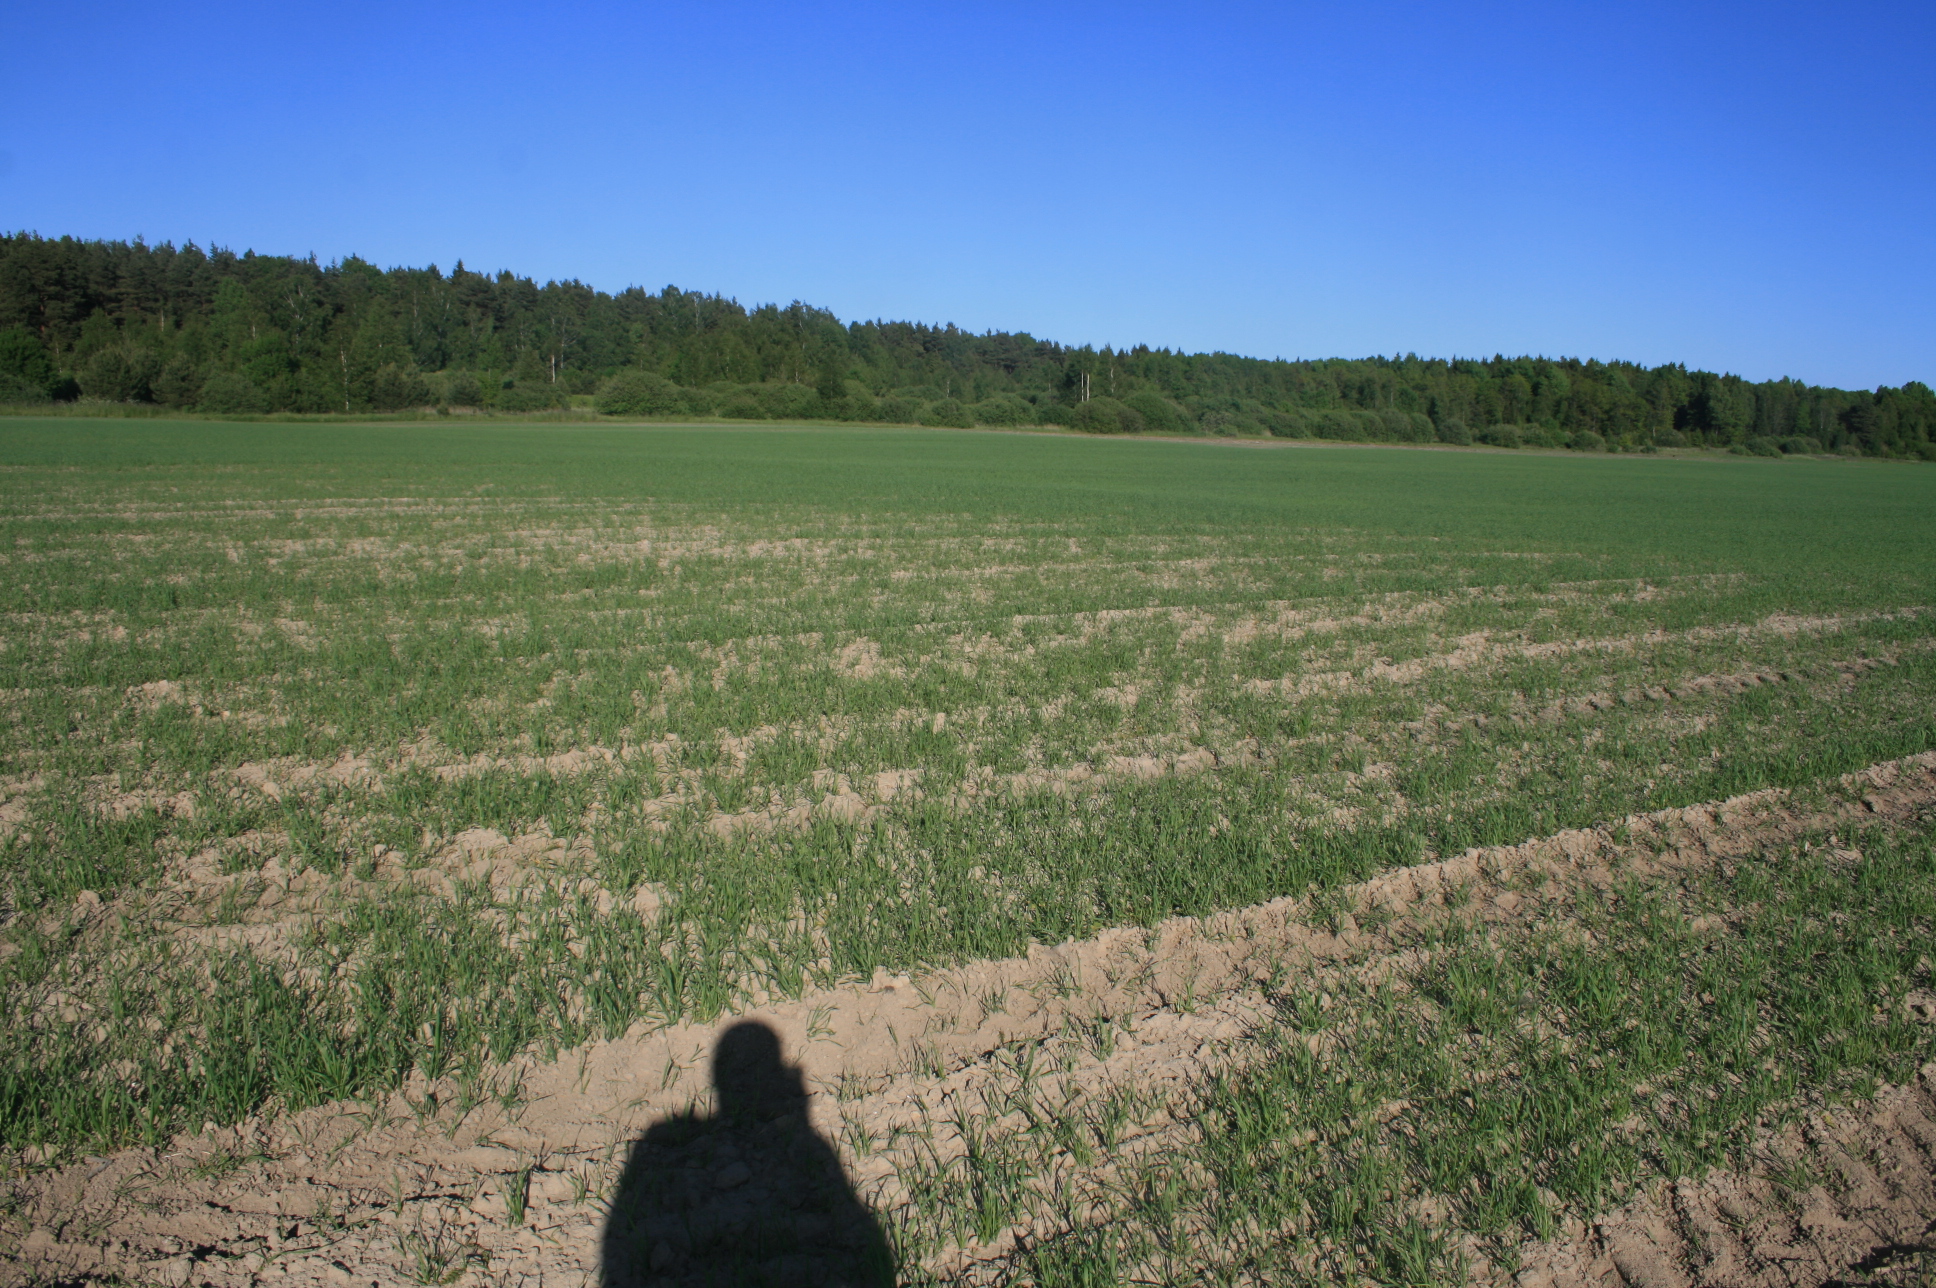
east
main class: Cropland
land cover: Barley
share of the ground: 50 - 75 %
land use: Agriculture (excluding fallow land and kitchen gardens)
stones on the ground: < 10 %
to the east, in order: Barley; Spontaneously vegetated surfaces; Broadleaved woodland; Spontaneously vegetated surfaces; Grassland with sparse tree/shrub cover; Inland fresh water bodies; Grassland with sparse tree/shrub cover
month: June
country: LT
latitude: 55.9210
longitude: 21.3235
